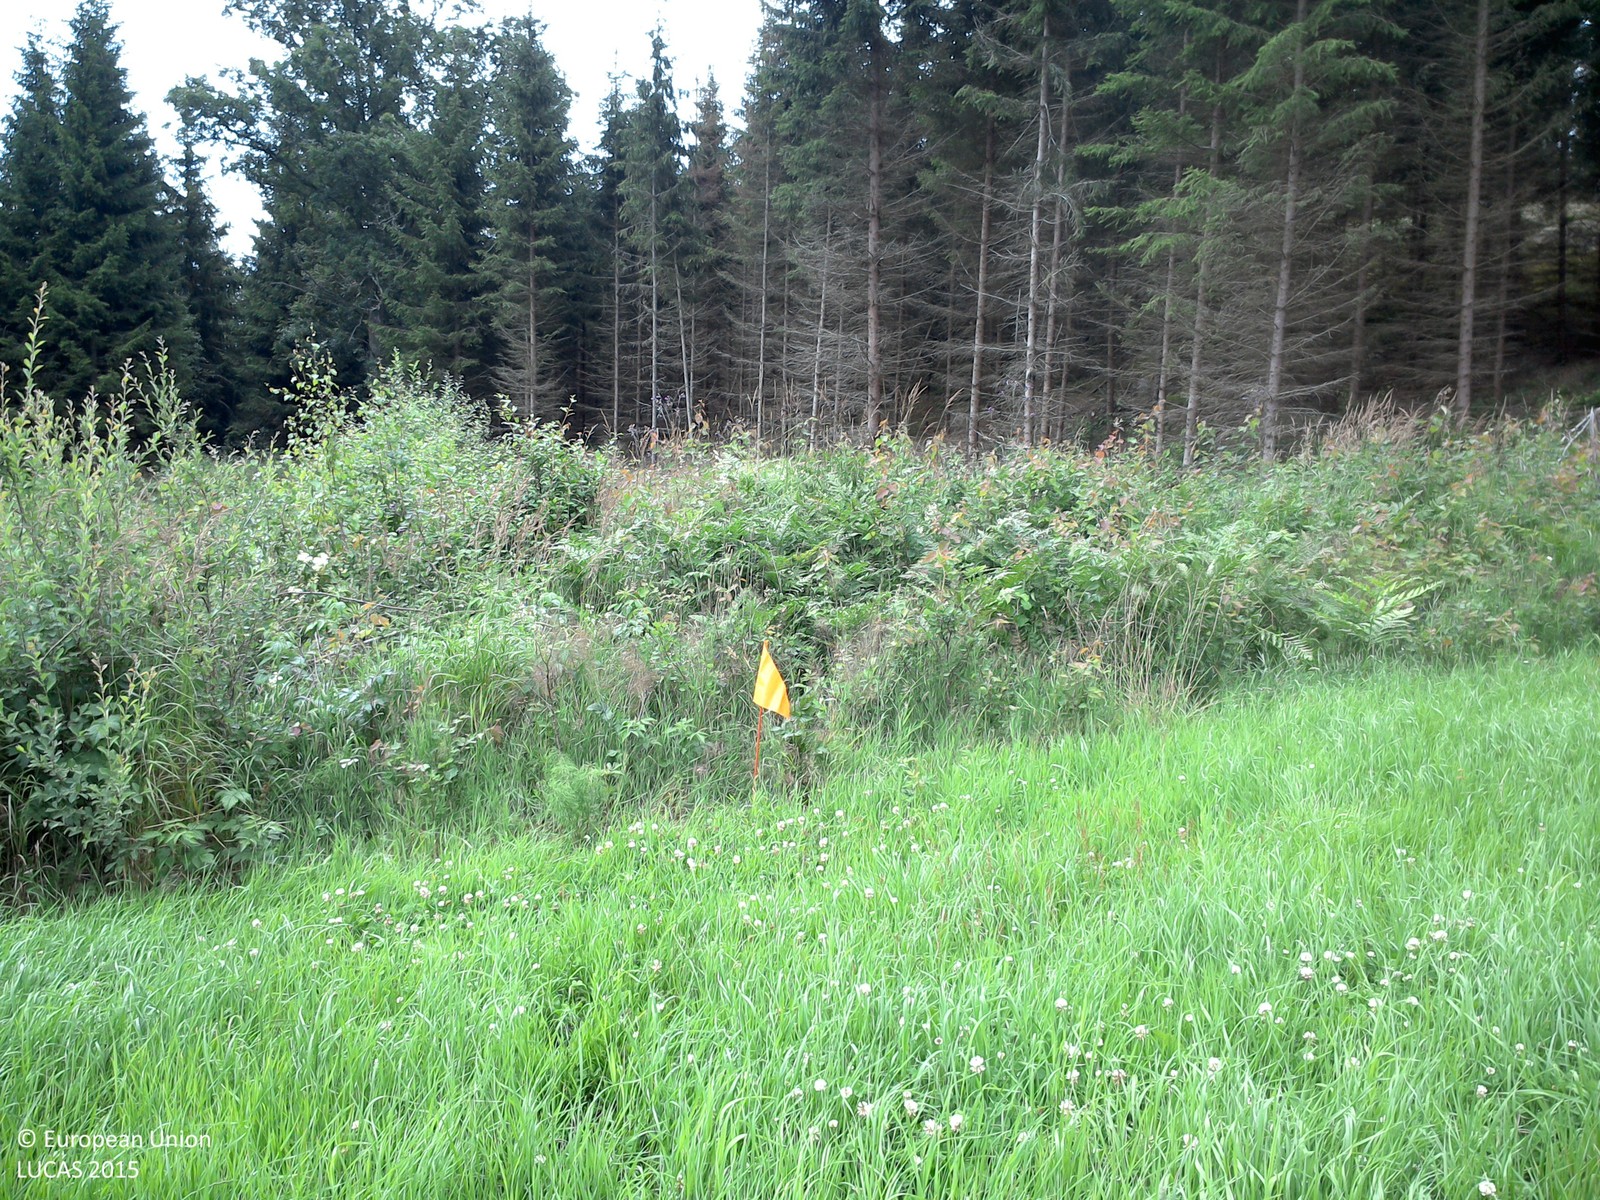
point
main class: Cropland
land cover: Other leguminous and mixtures for fodder
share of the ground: > 75 %
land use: Agriculture (excluding fallow land and kitchen gardens)
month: July
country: SE
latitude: 57.7430
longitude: 15.9944
